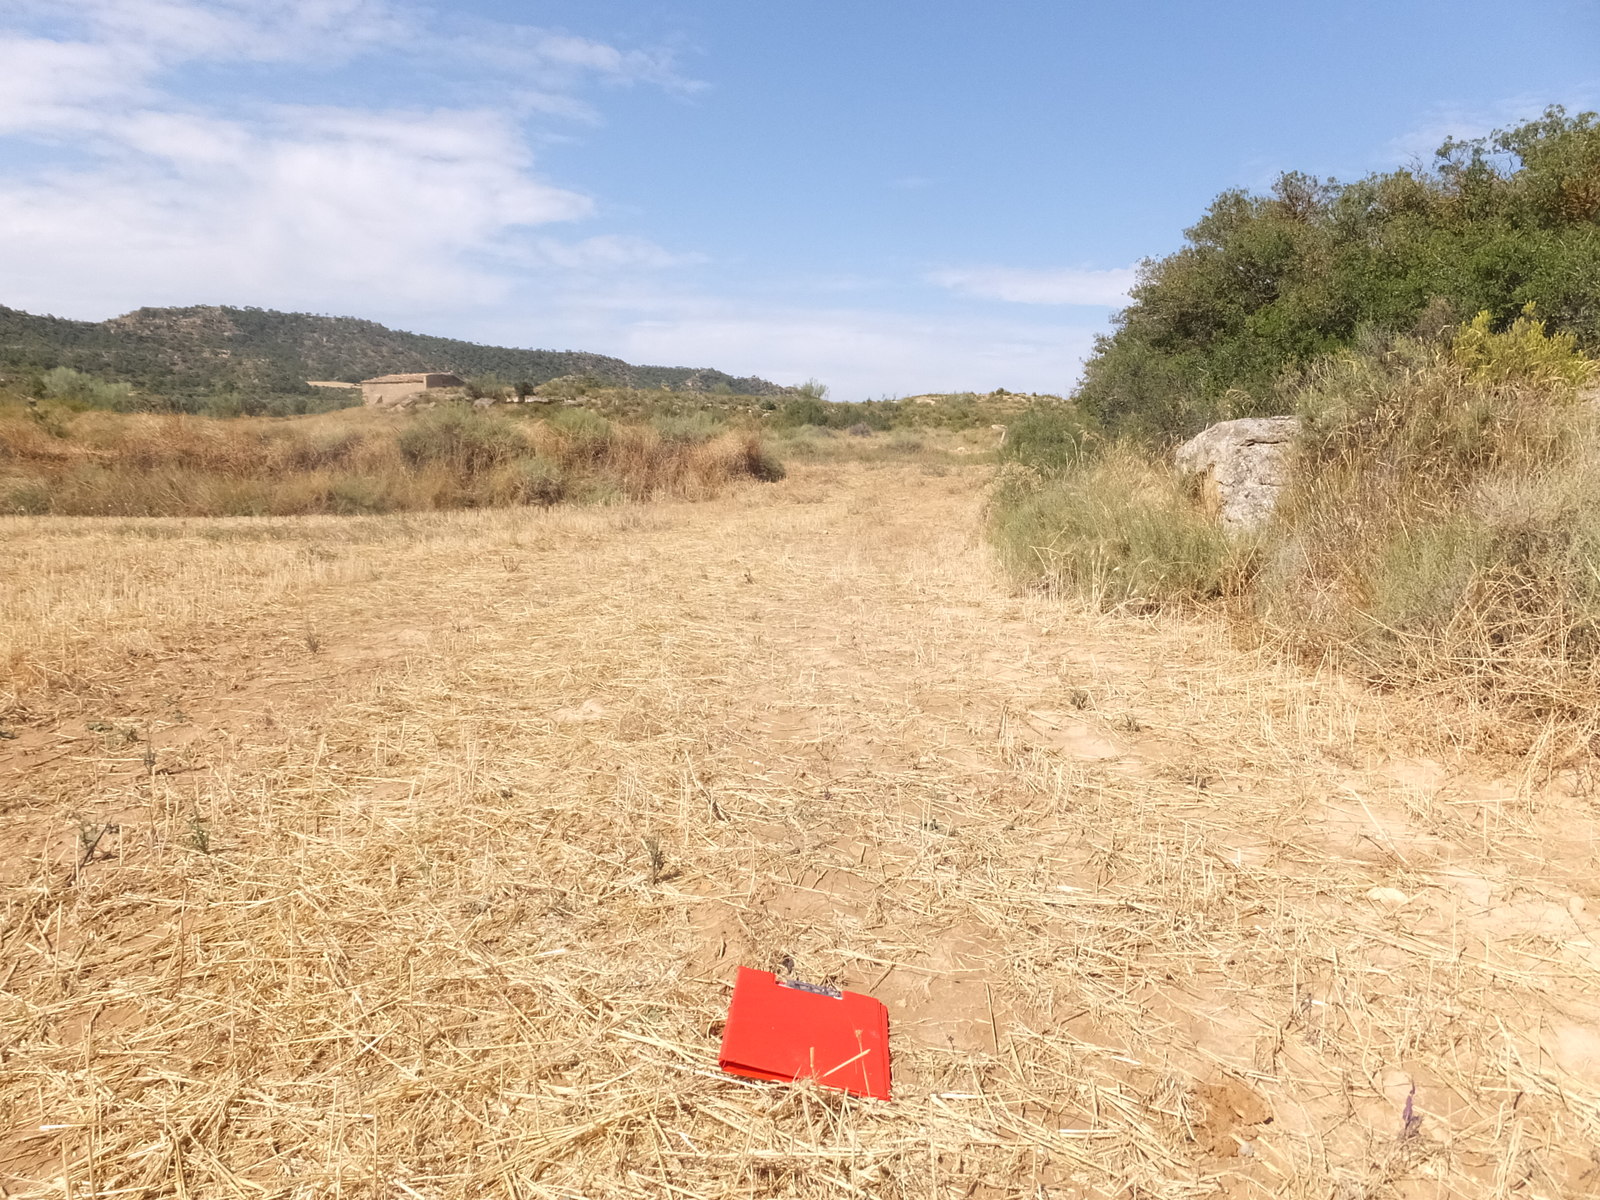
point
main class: Cropland
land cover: Barley
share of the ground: < 10 %
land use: Agriculture (excluding fallow land and kitchen gardens)
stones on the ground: < 10 %
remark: Harvested field
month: July
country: ES
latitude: 41.1695
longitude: -0.0598
